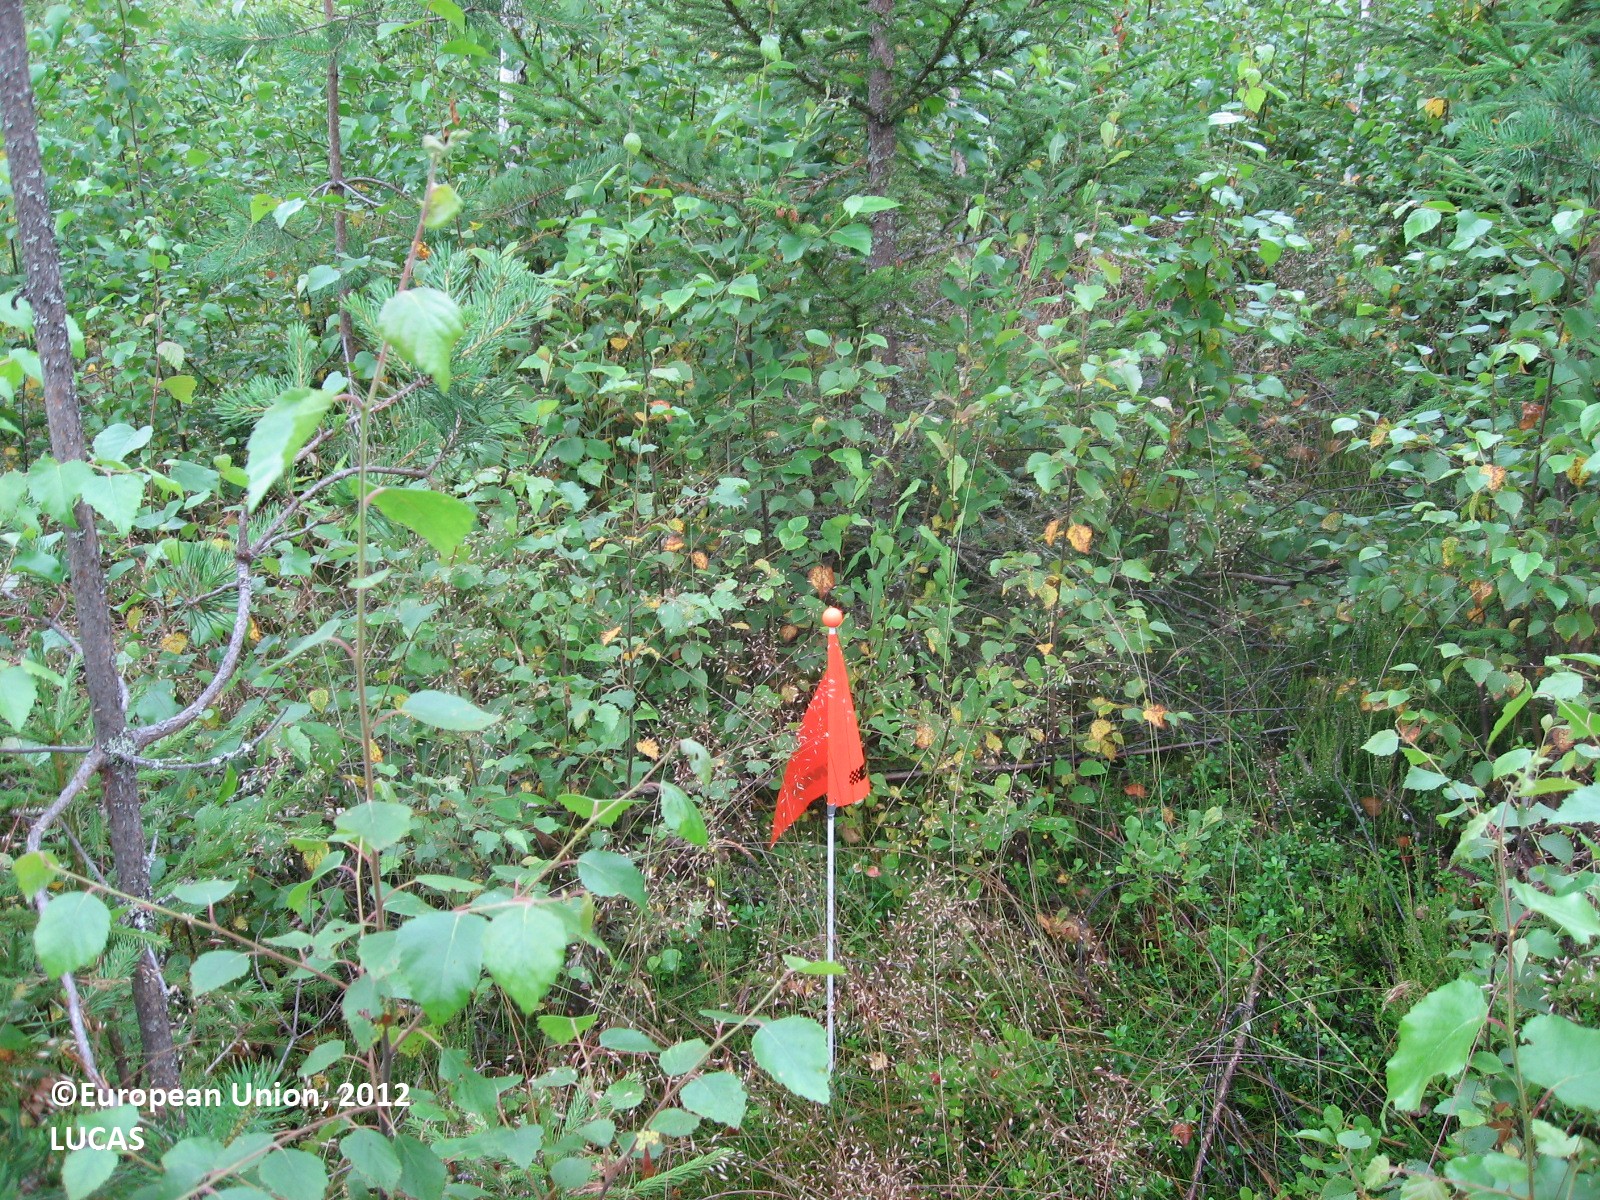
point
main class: Woodland
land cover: Spruce dominated mixed woodland
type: boreal forest
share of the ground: > 75 %
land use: Forestry
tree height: < 5 m
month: July
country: FI
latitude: 61.3844
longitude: 25.9497
